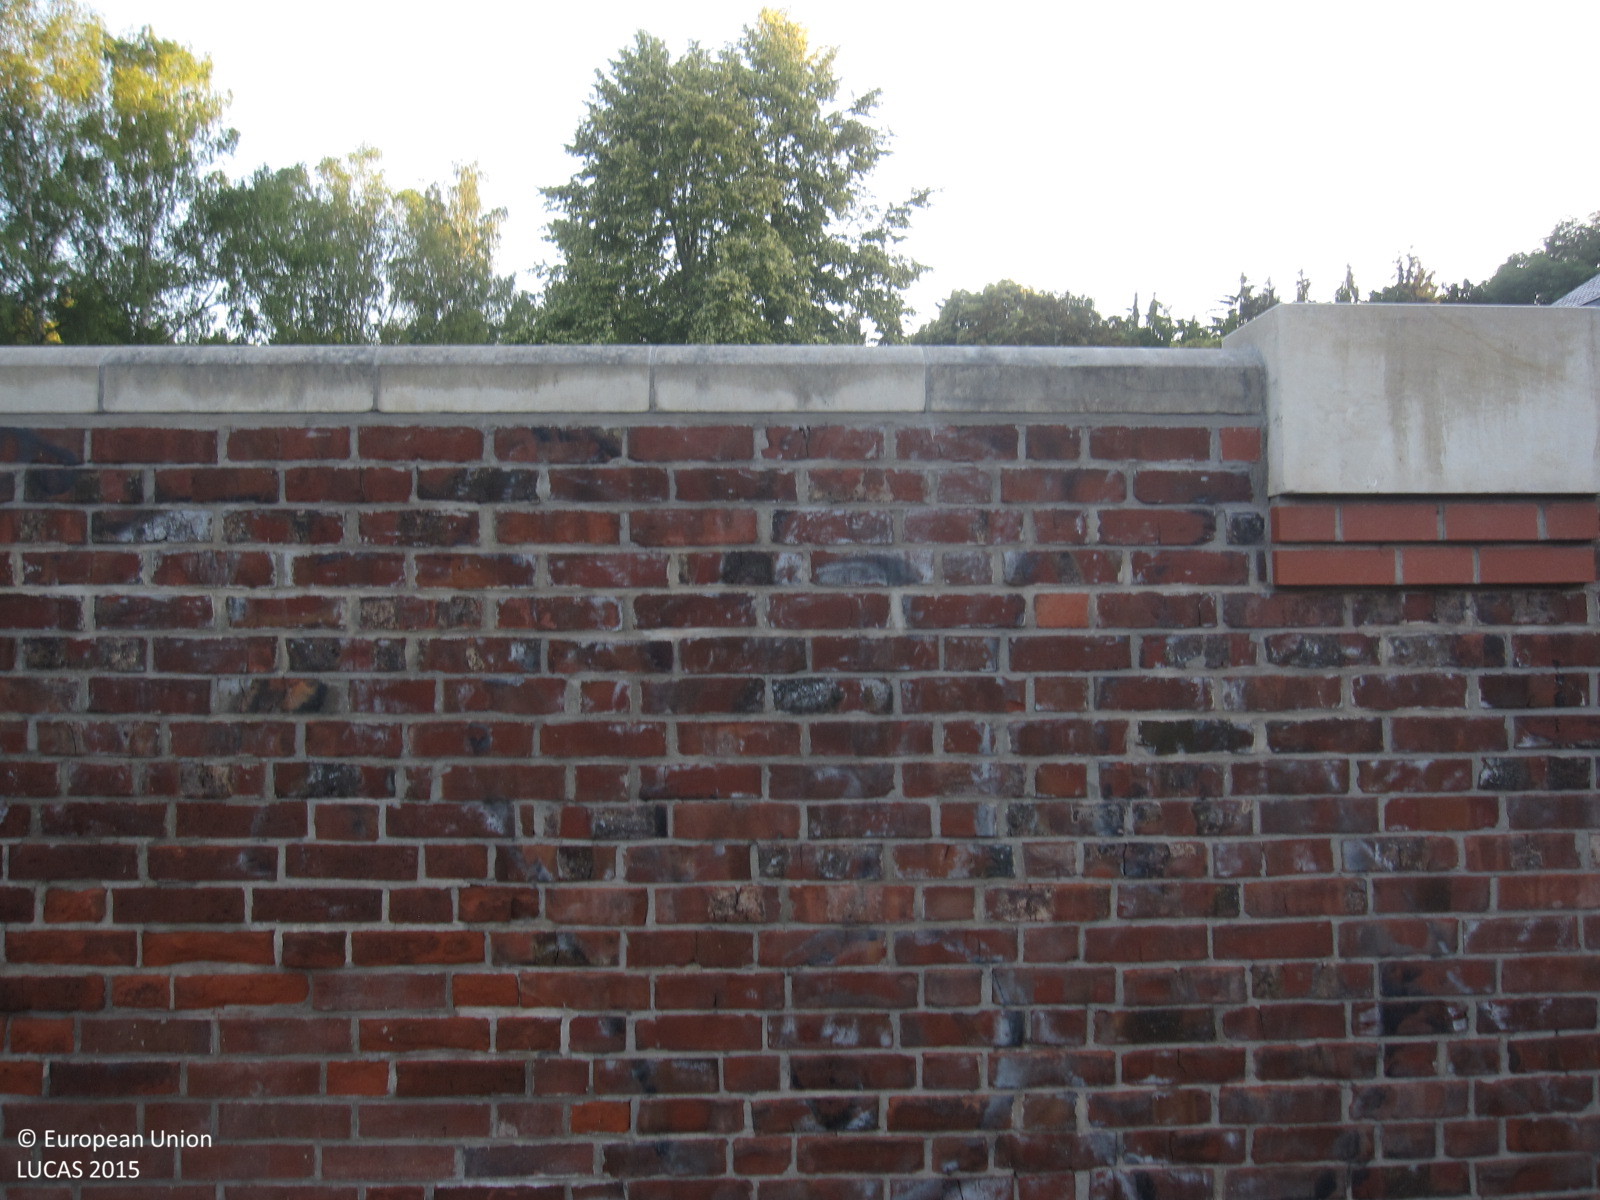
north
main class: Grassland
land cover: Grassland with sparse tree/shrub cover
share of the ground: > 75 %
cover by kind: herbaceous plants 95 %, broadleaved forest trees 5 %
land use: Residential
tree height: > 5 m
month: July
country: DE
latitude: 50.8671
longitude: 12.0600
